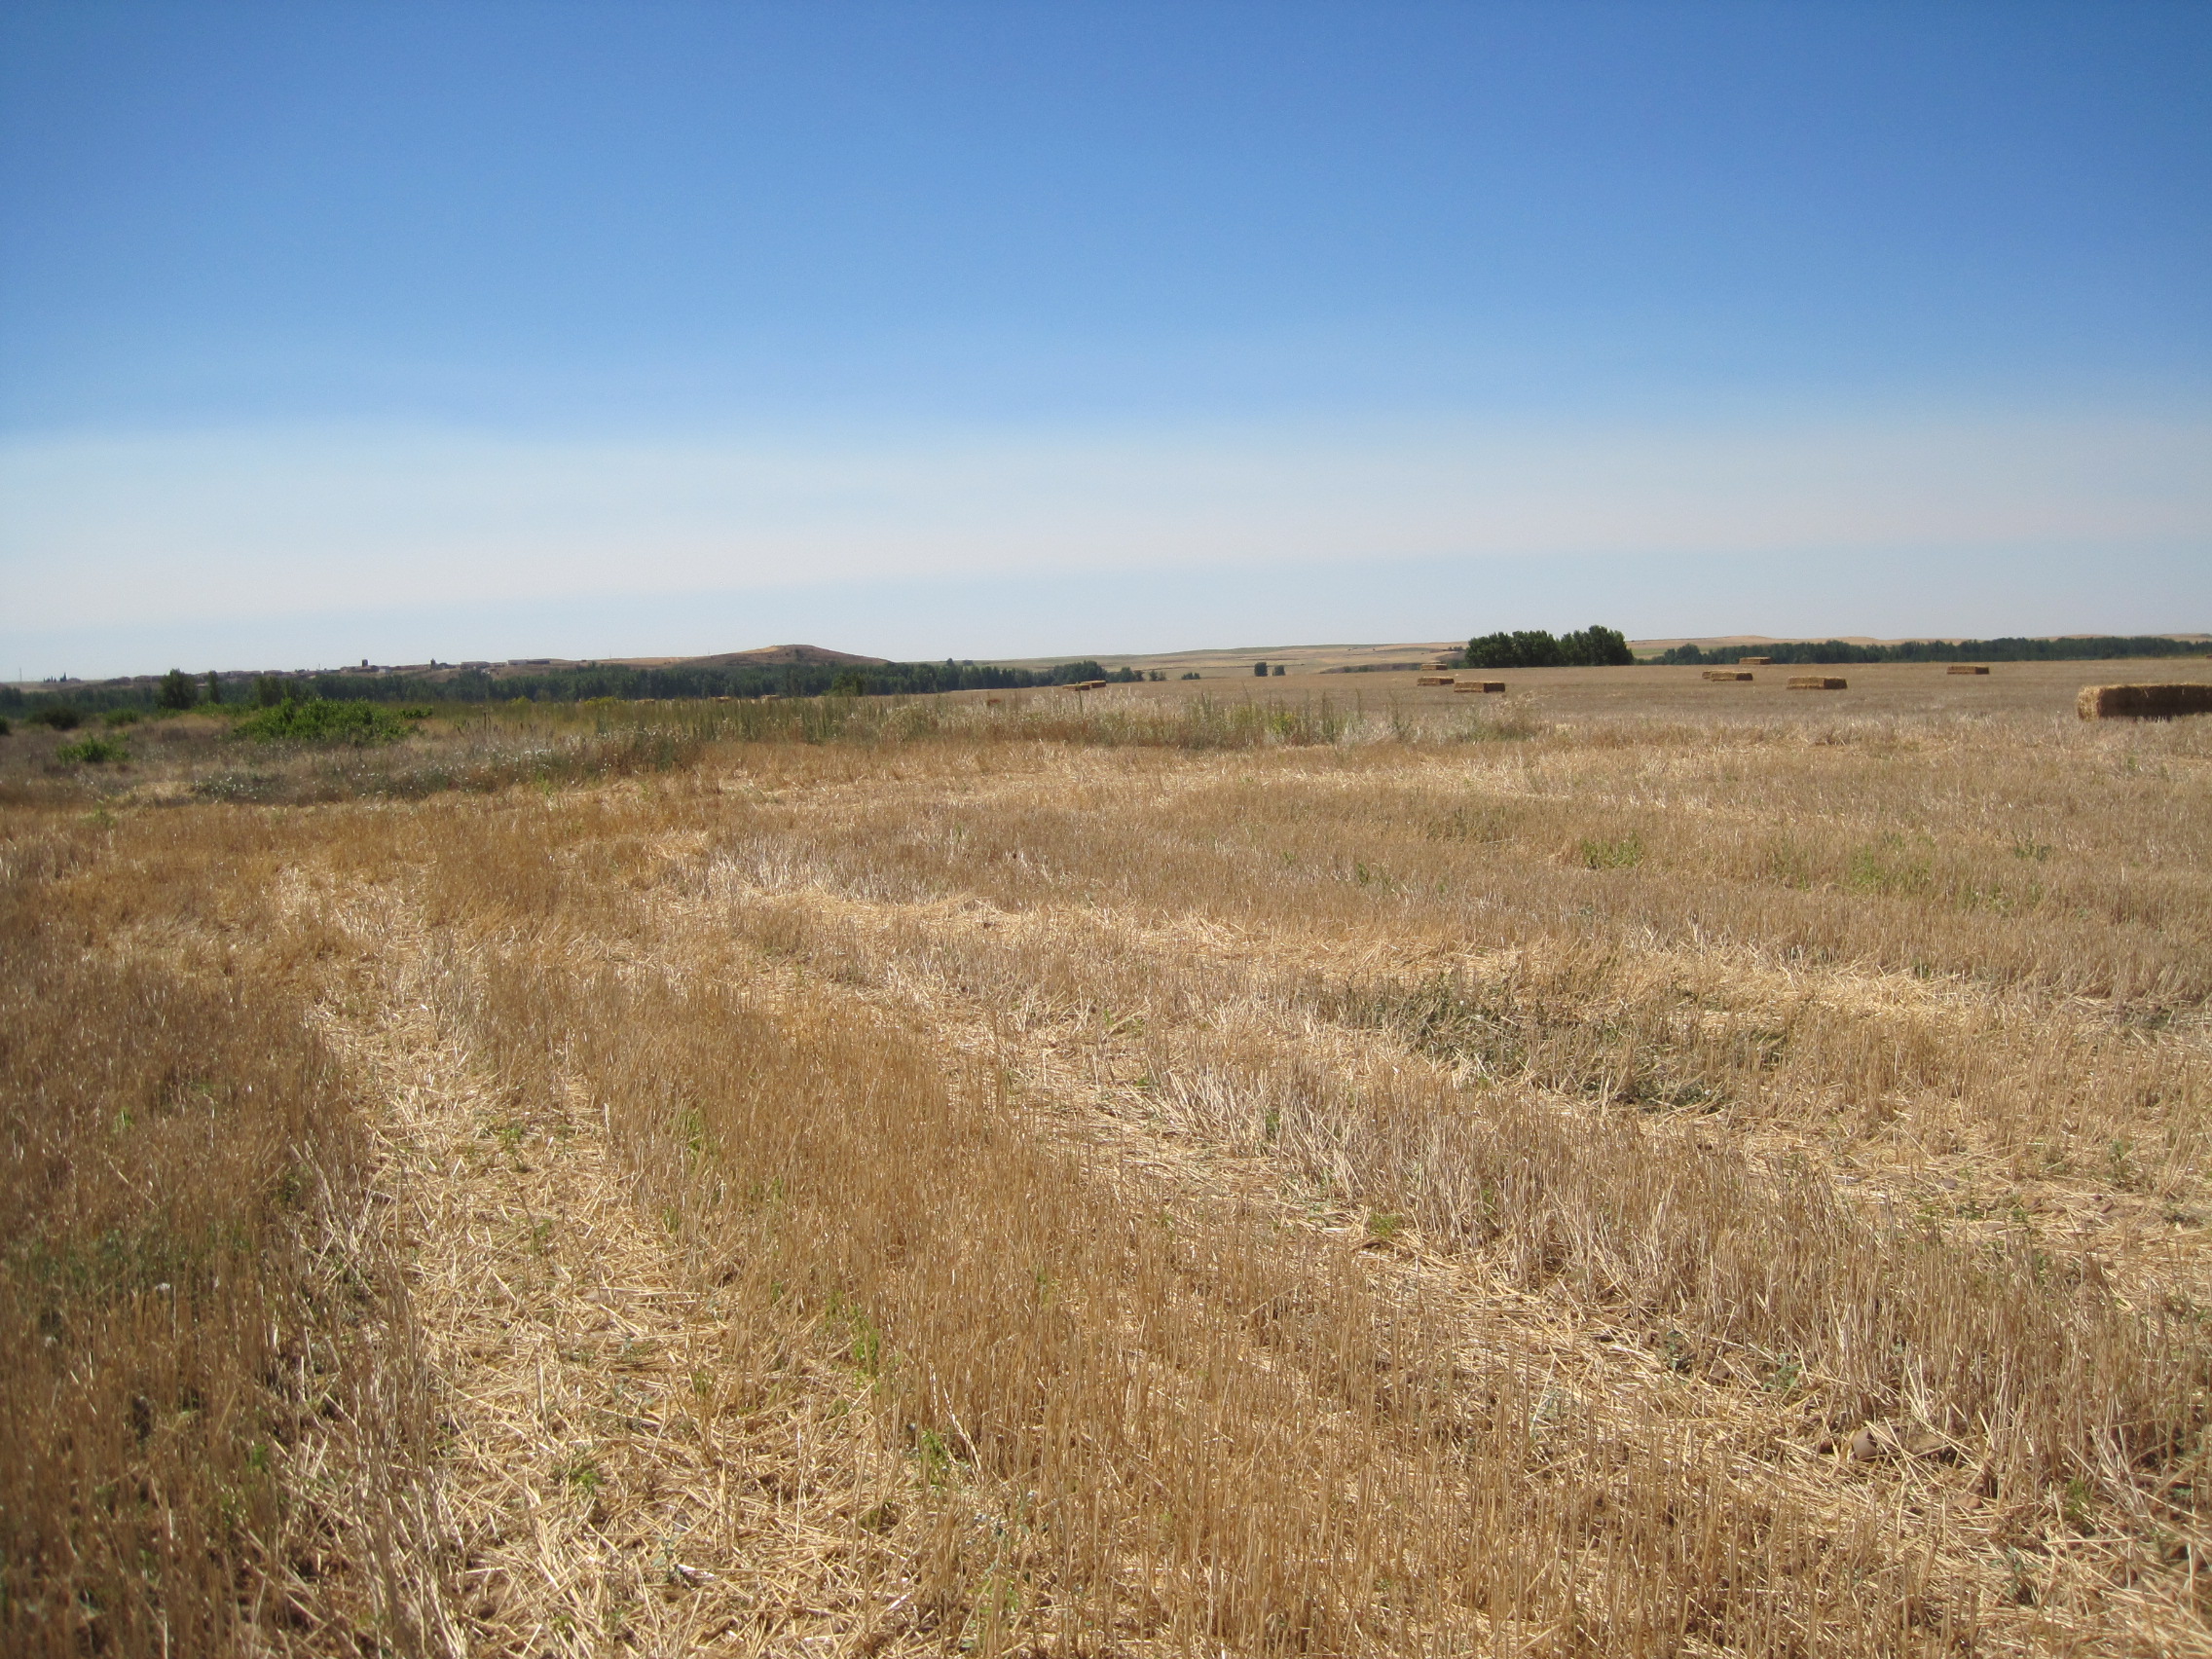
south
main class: Cropland
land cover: Common wheat
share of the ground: < 10 %
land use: Agriculture (excluding fallow land and kitchen gardens)
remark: Harvested field
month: July
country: ES
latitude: 42.1588
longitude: -5.3242
